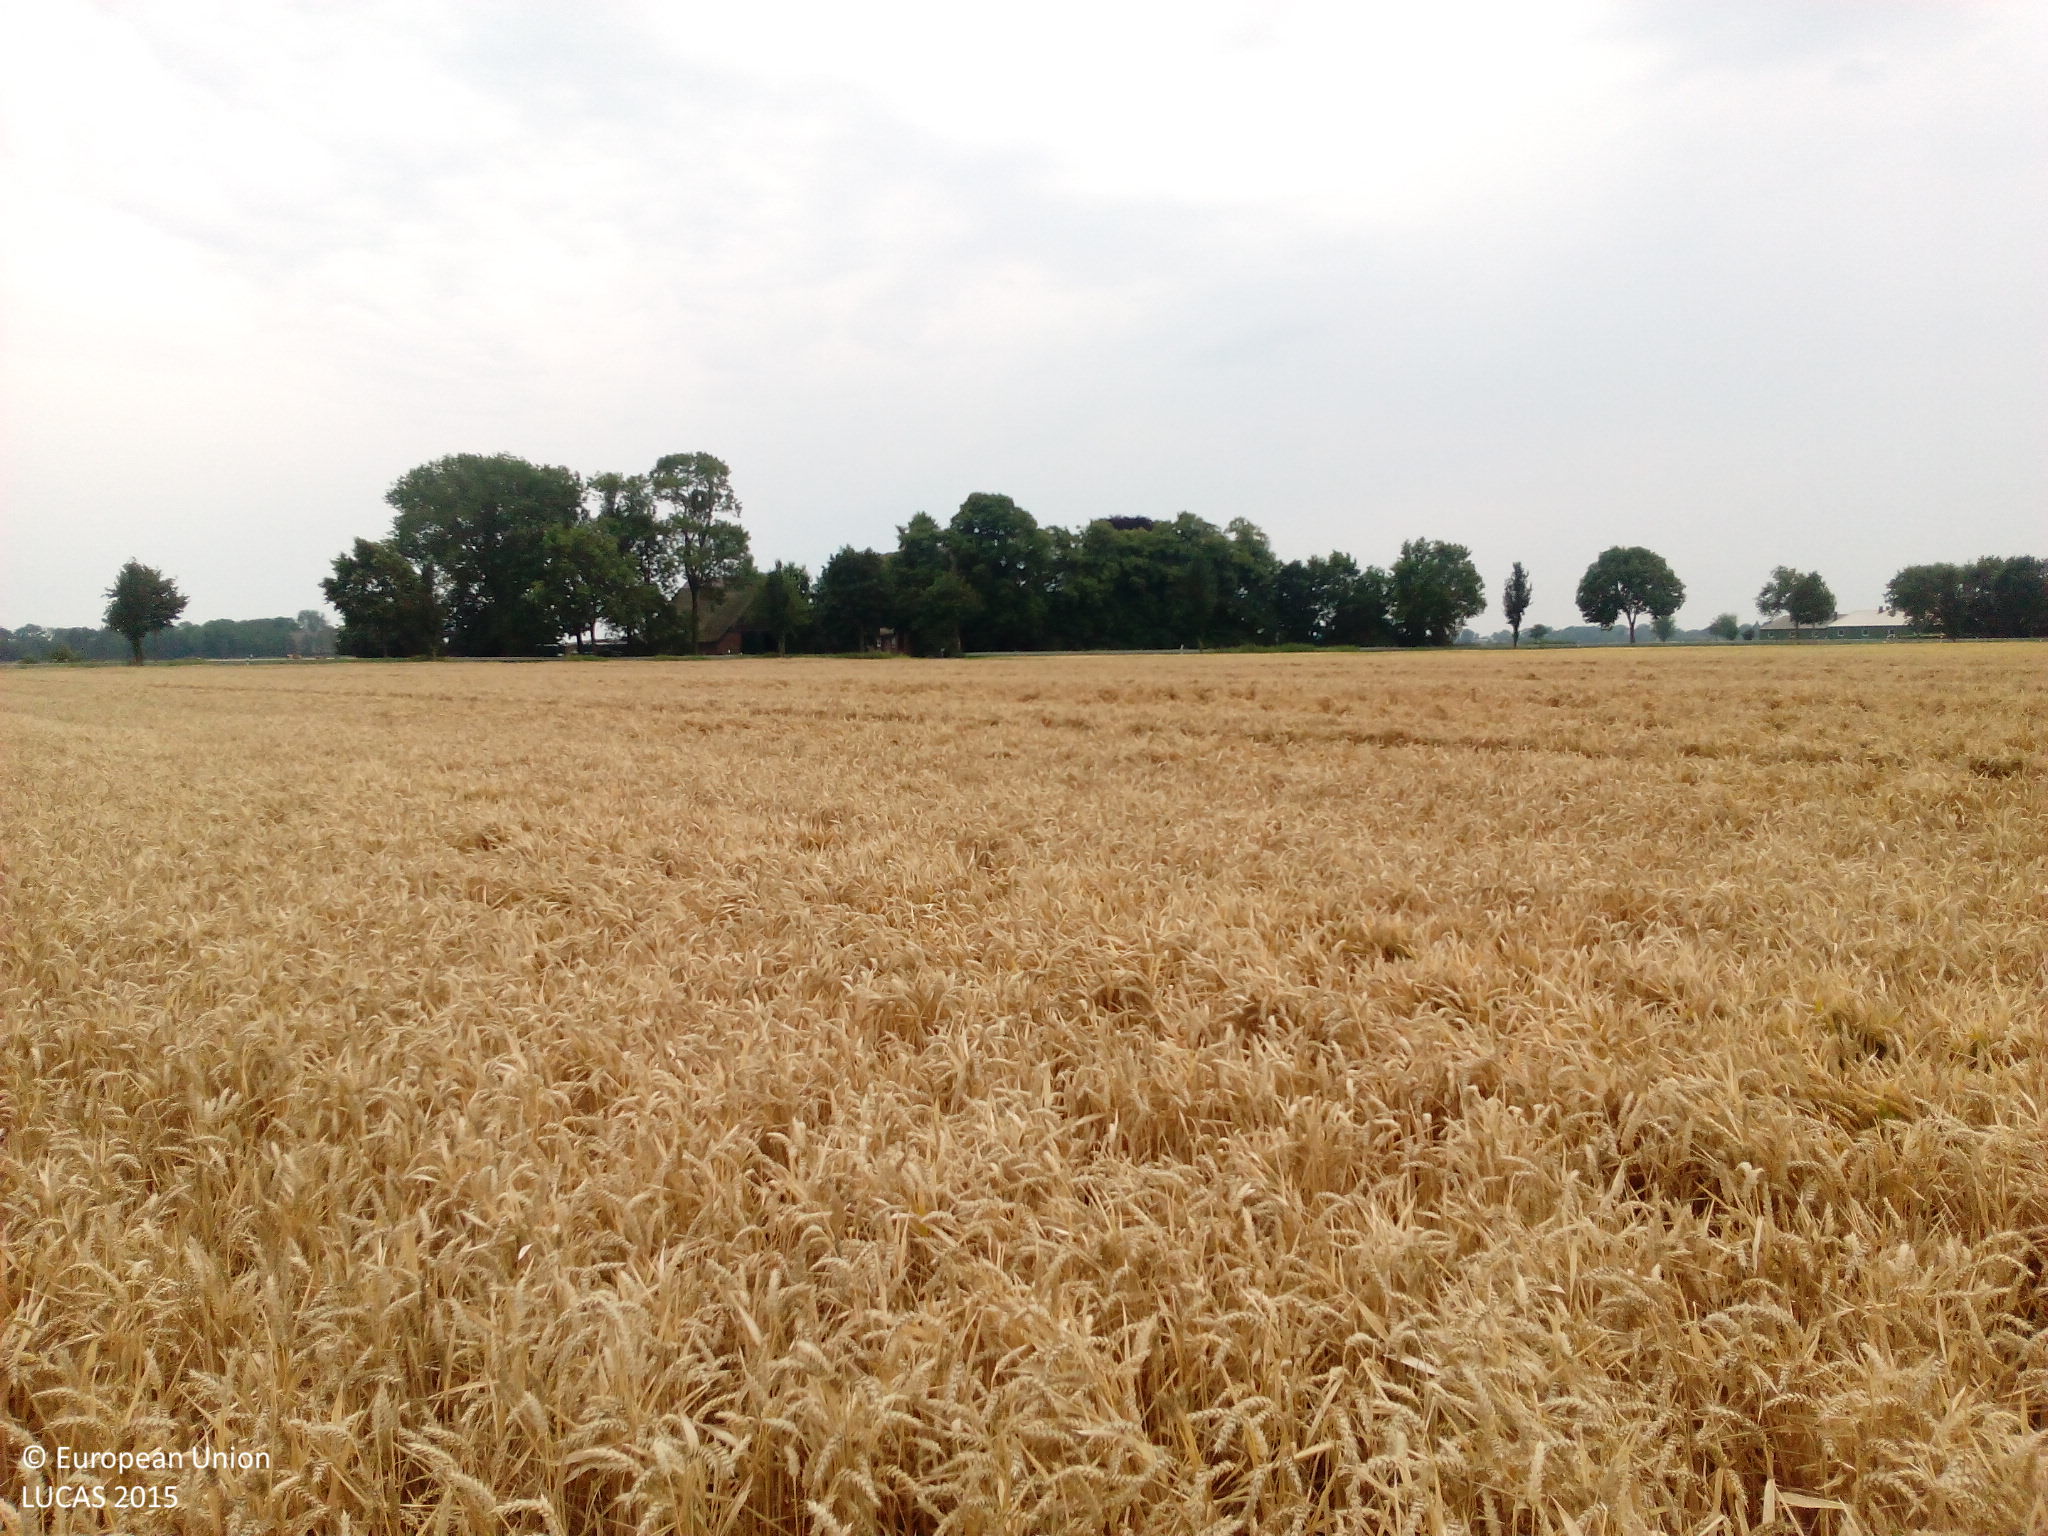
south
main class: Cropland
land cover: Common wheat
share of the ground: > 75 %
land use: Agriculture (excluding fallow land and kitchen gardens)
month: August
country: DE
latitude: 53.8145
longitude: 9.5598
